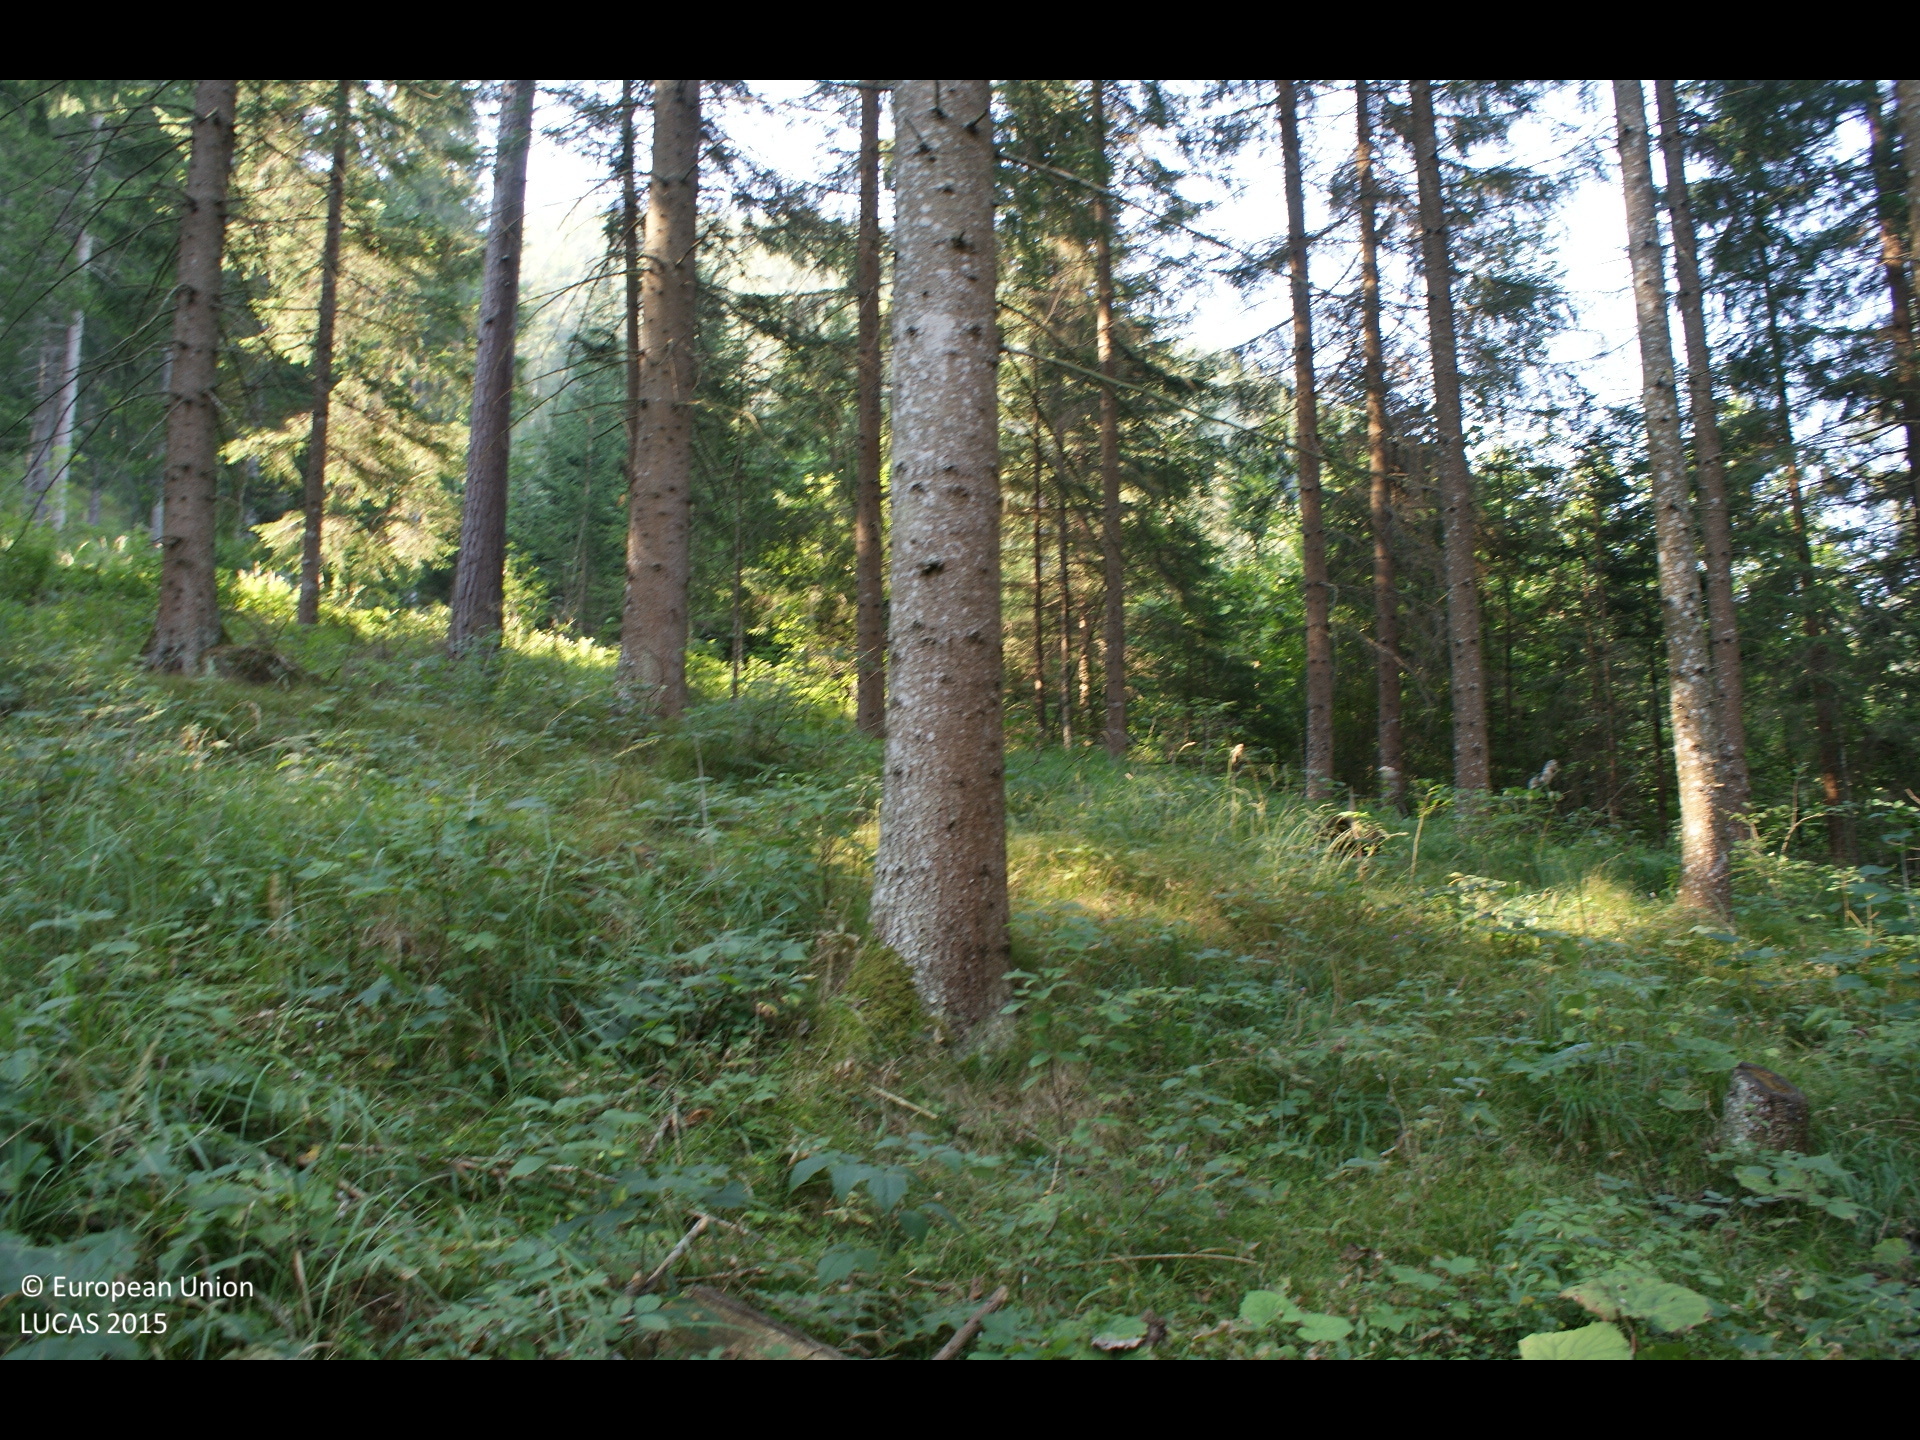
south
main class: Woodland
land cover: Spruce dominated coniferous woodland
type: alpine coniferous forest
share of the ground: 50 - 75 %
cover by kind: coniferous forest trees 50 %, shrubs 30 %, herbaceous plants 20 %
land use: Forestry
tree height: > 5 m
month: August
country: AT
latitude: 47.5369
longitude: 15.3011
